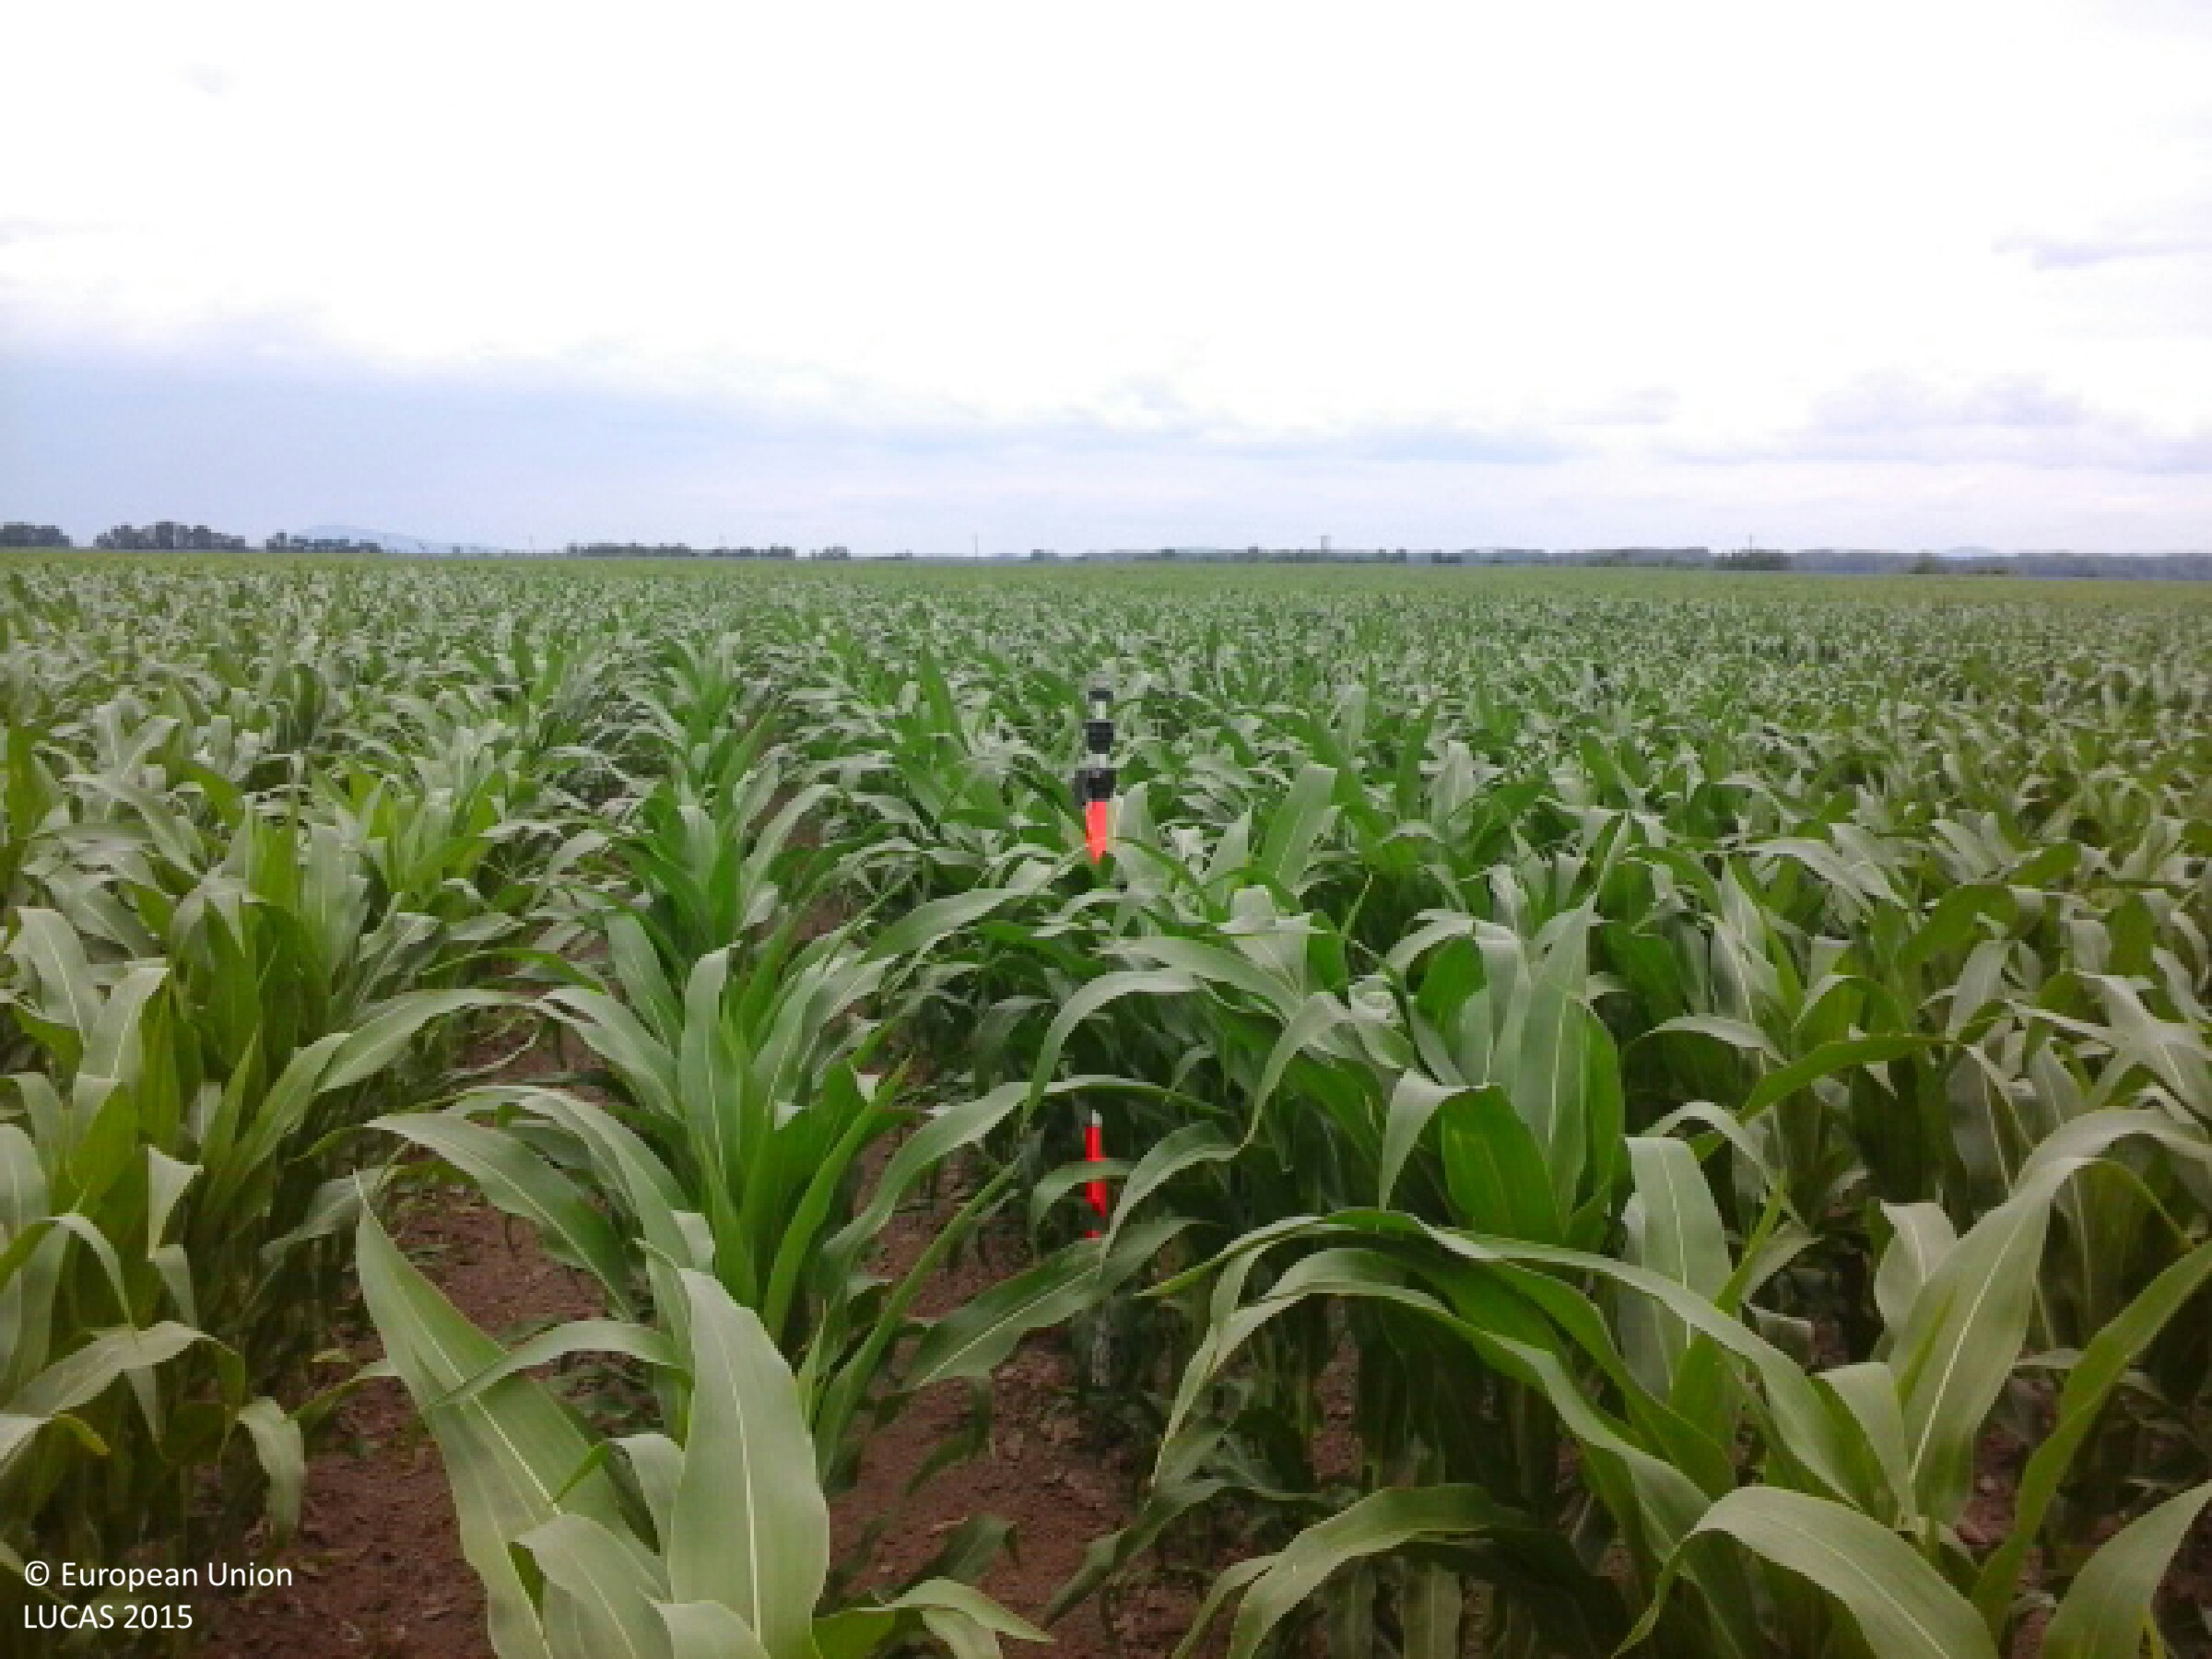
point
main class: Cropland
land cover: Maize
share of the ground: 50 - 75 %
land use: Agriculture (excluding fallow land and kitchen gardens)
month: June
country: HU
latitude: 48.1583
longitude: 21.7315
